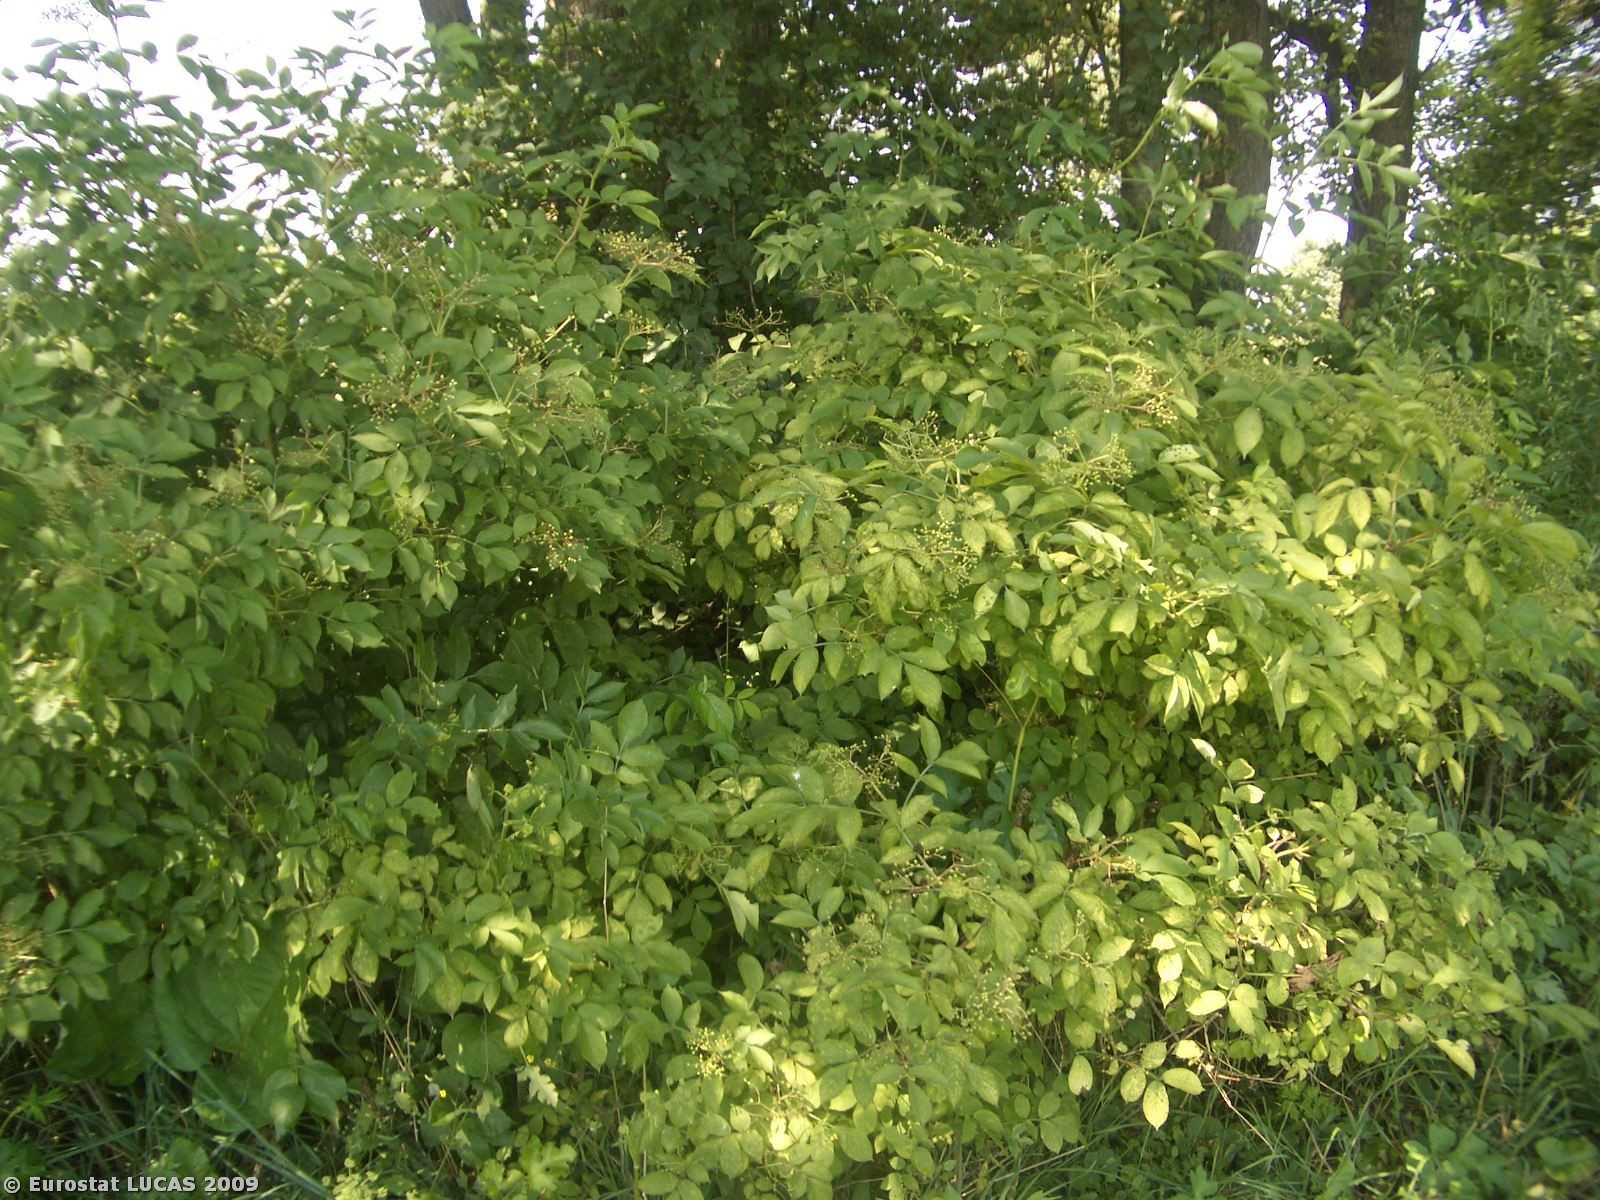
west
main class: Woodland
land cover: Broadleaved woodland
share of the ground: > 75 %
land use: Forestry
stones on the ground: < 10 %
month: July
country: PL
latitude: 52.0669
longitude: 22.5989
